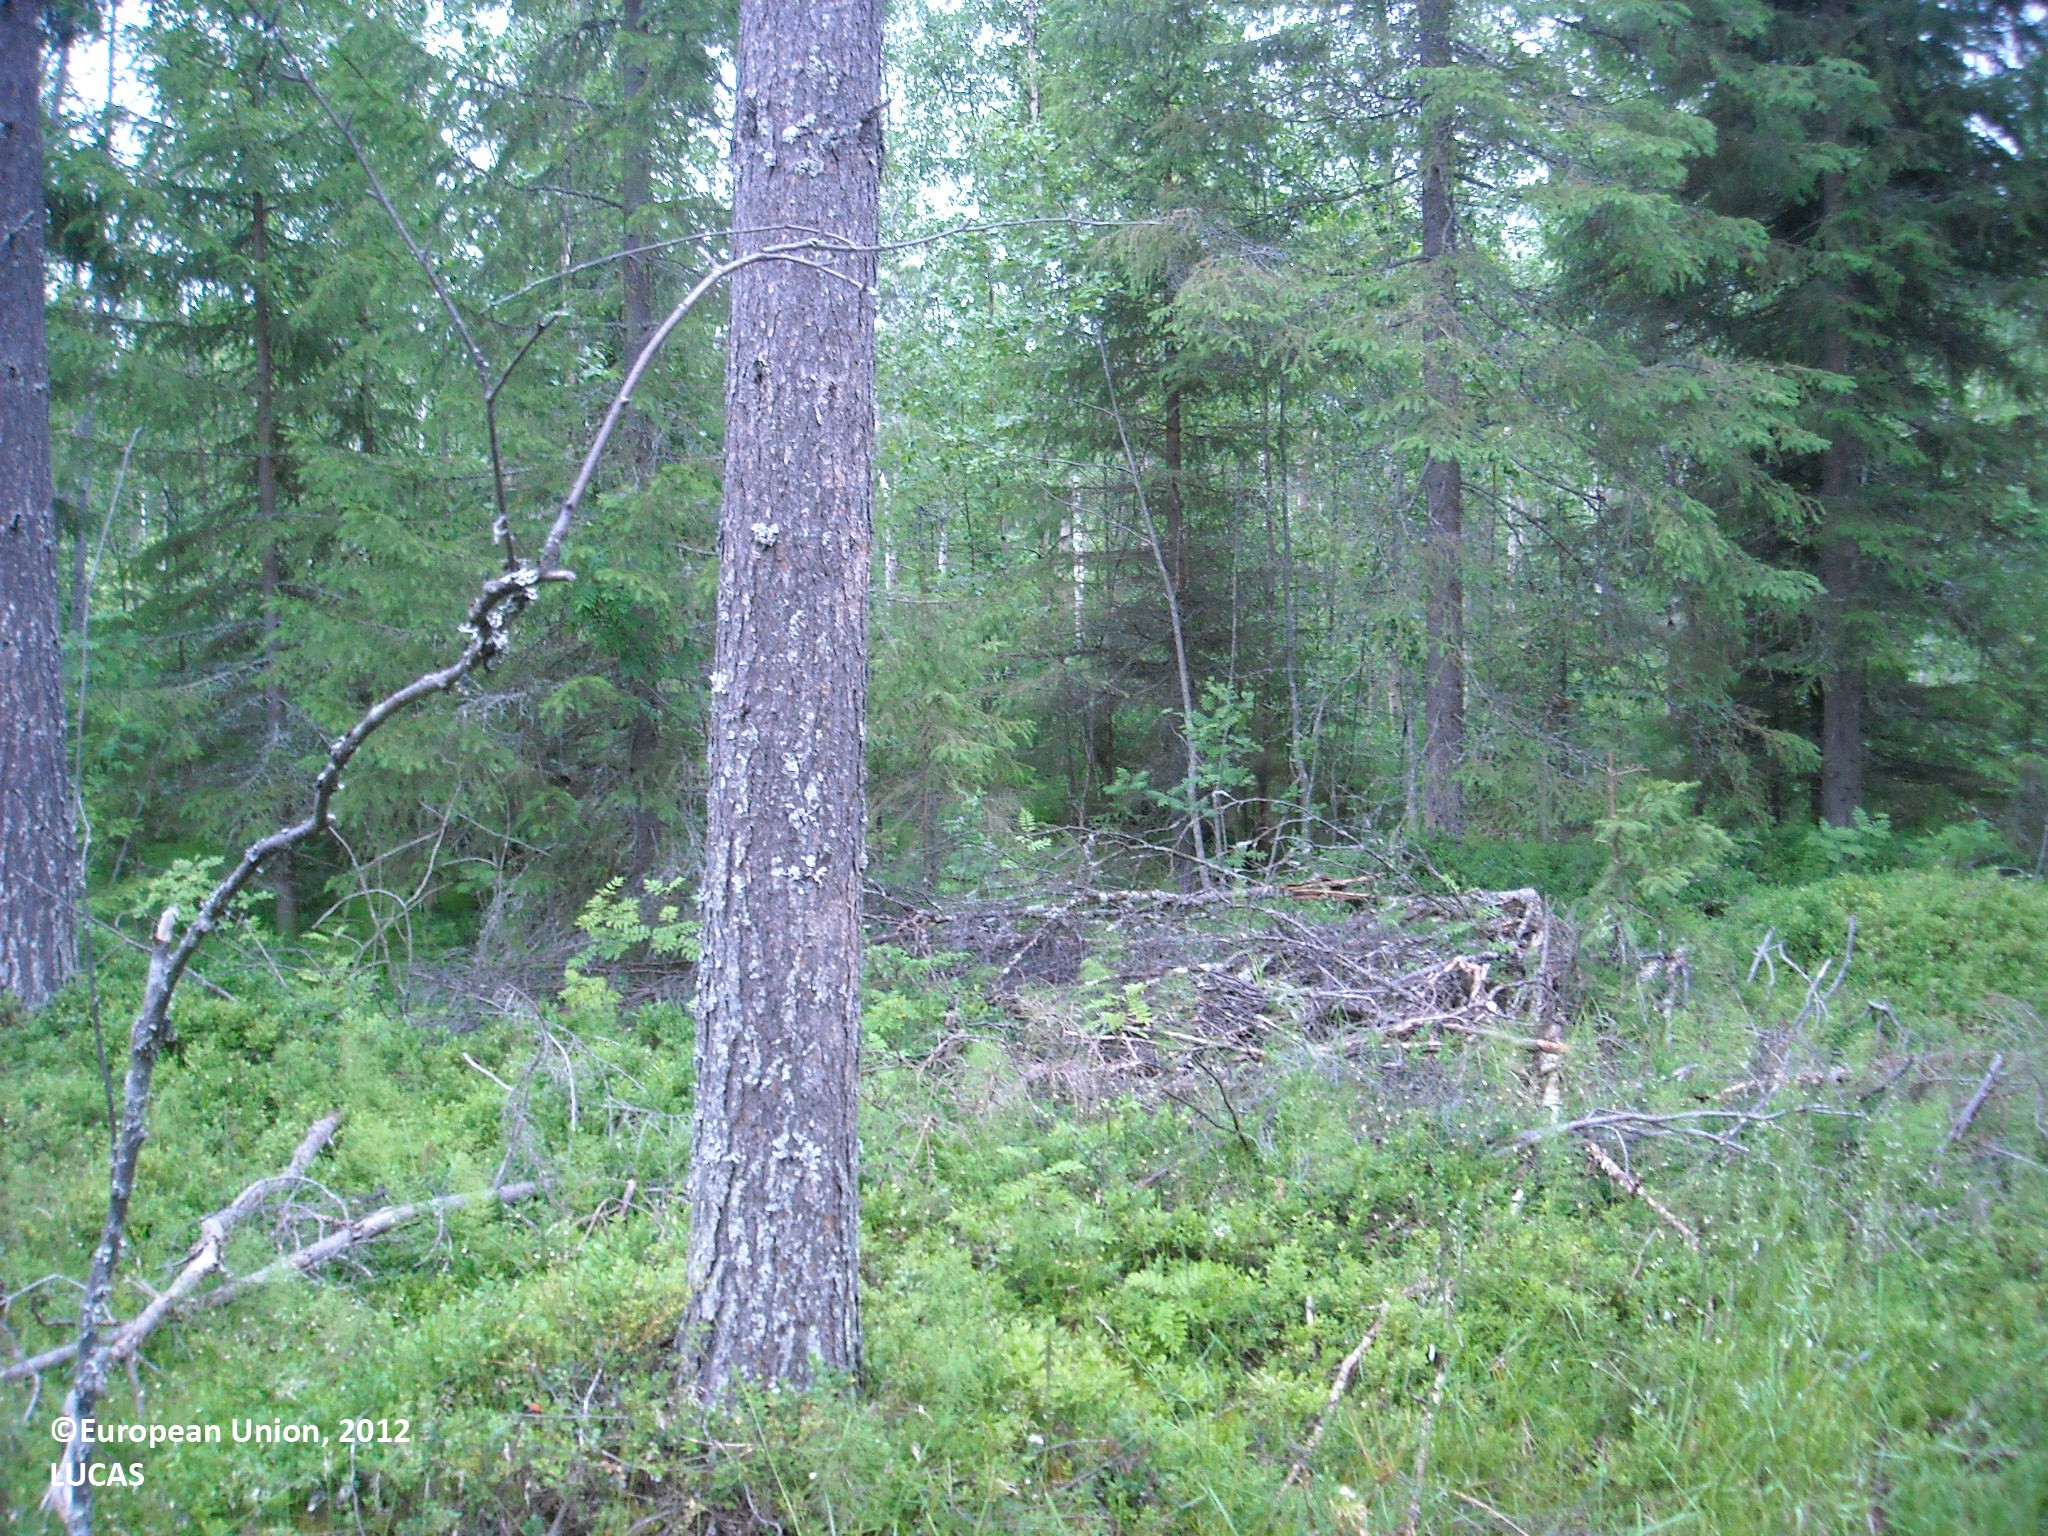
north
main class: Woodland
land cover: Other coniferous woodland
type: mire and swamp forests
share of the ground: > 75 %
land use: Forestry
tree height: > 5 m
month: July
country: FI
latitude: 64.4118
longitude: 27.5567
